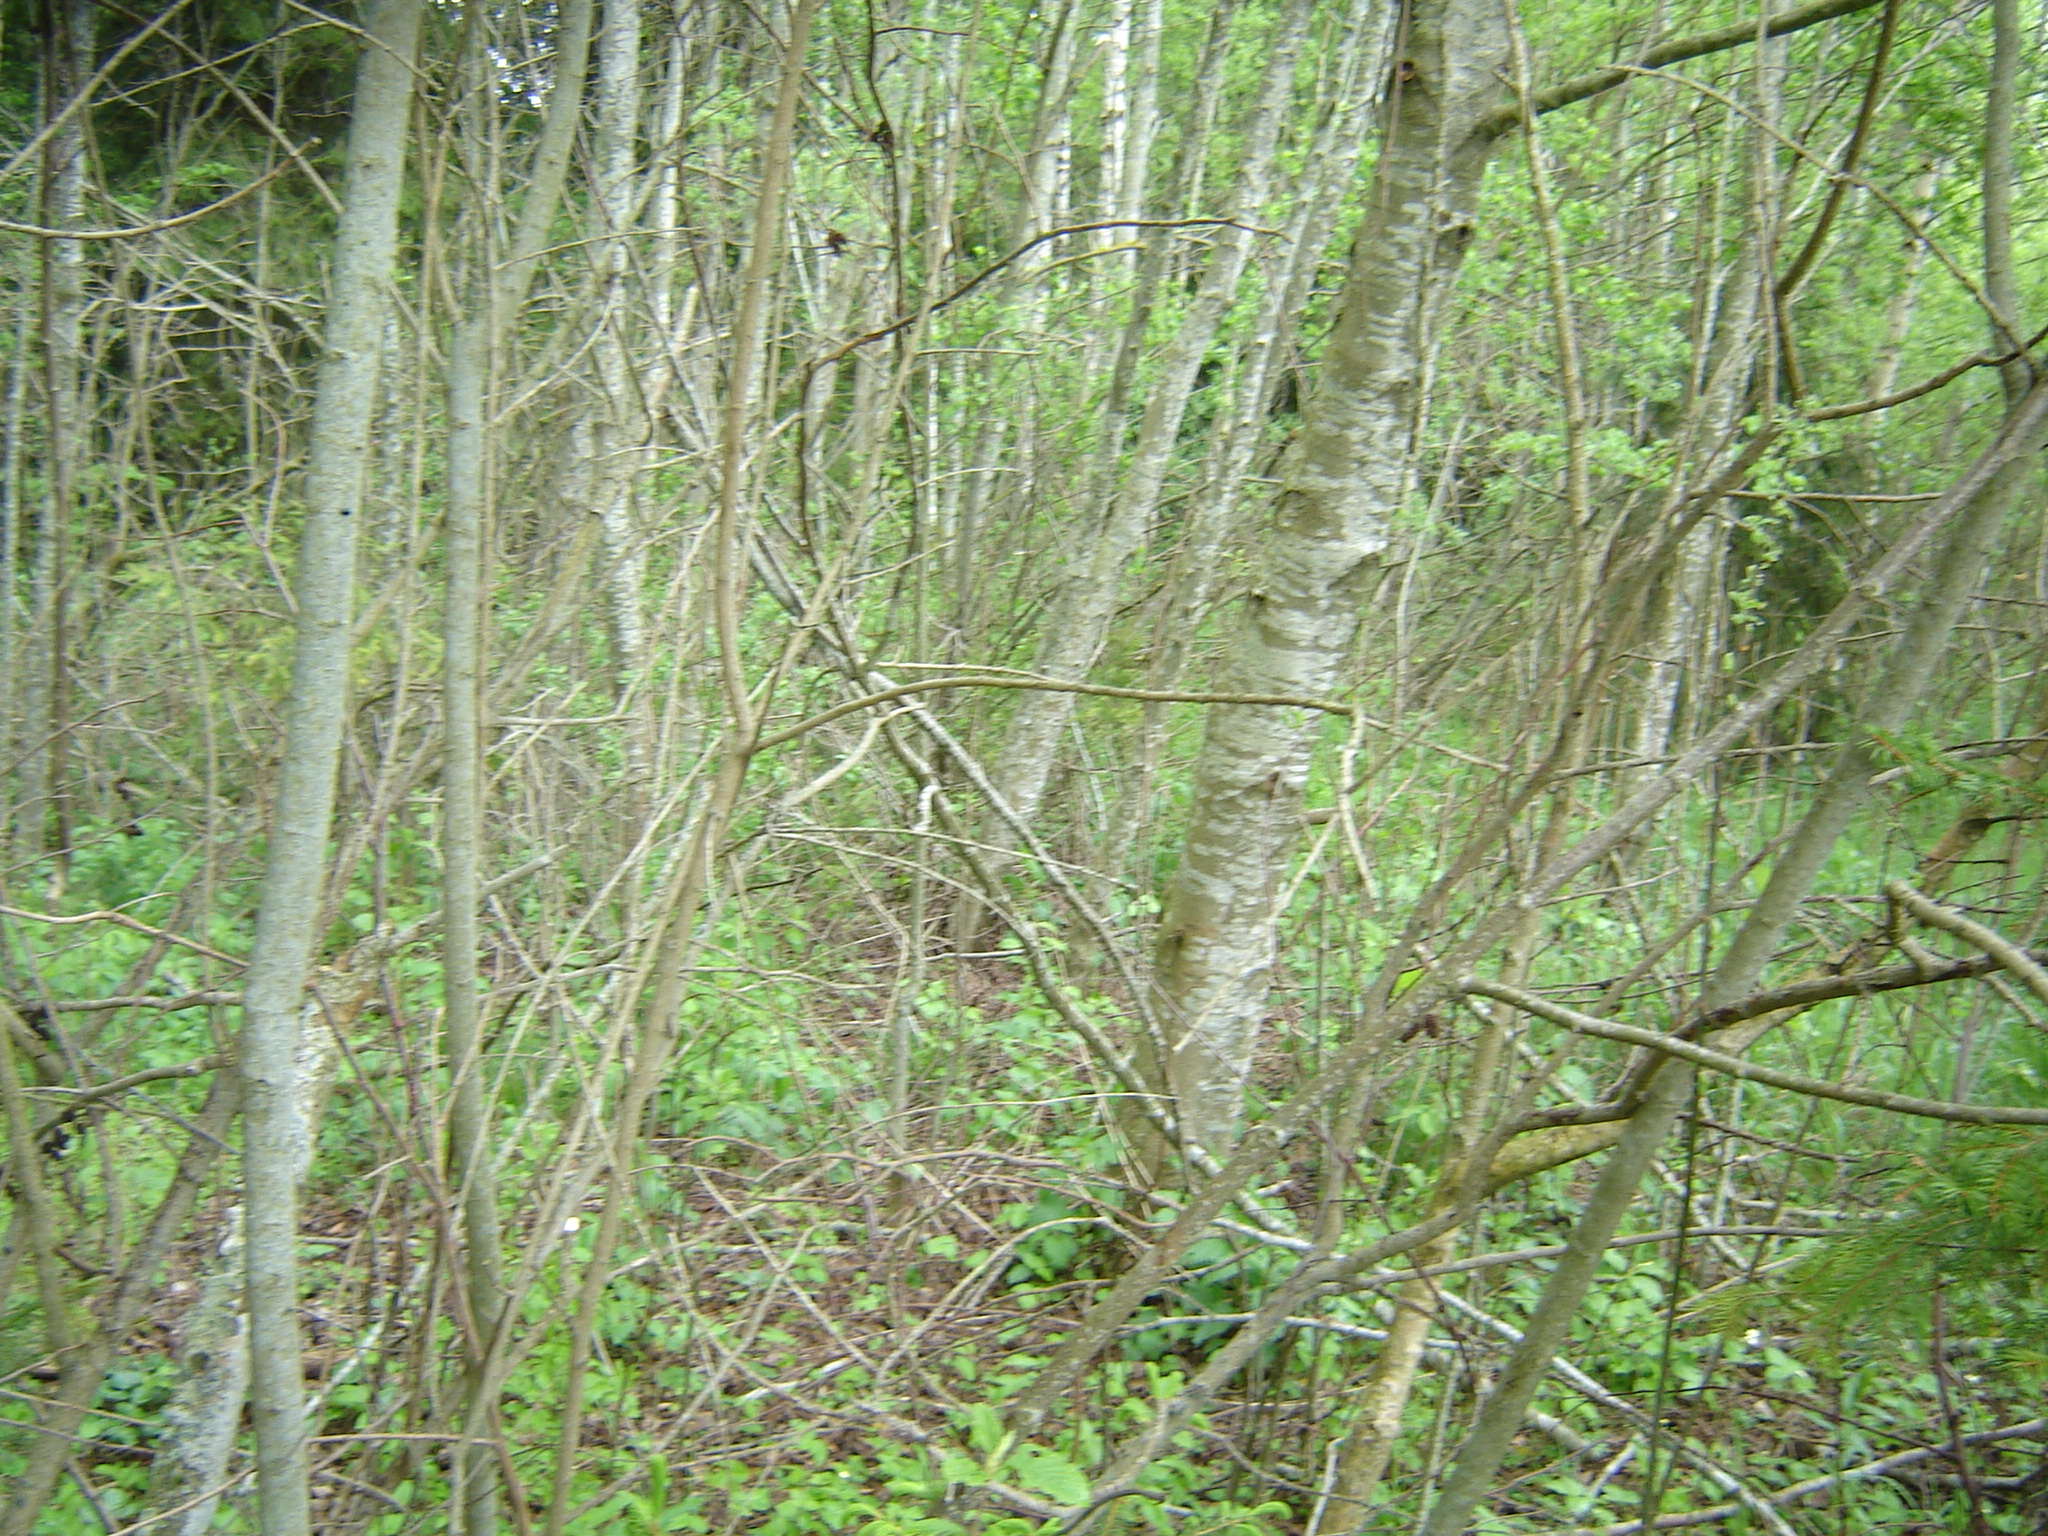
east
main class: Woodland
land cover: Broadleaved woodland
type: non-riverine alder, birch or aspen forest
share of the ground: > 75 %
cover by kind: broadleaved forest trees 80 %, herbaceous plants 10 %, coniferous forest trees 5 %, shrubs 5 %
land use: Forestry
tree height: > 5 m
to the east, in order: Broadleaved woodland; Ditches and canals; Broadleaved woodland; Spruce dominated mixed woodland; Broadleaved woodland
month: May
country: LT
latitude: 56.1008
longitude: 25.3425
